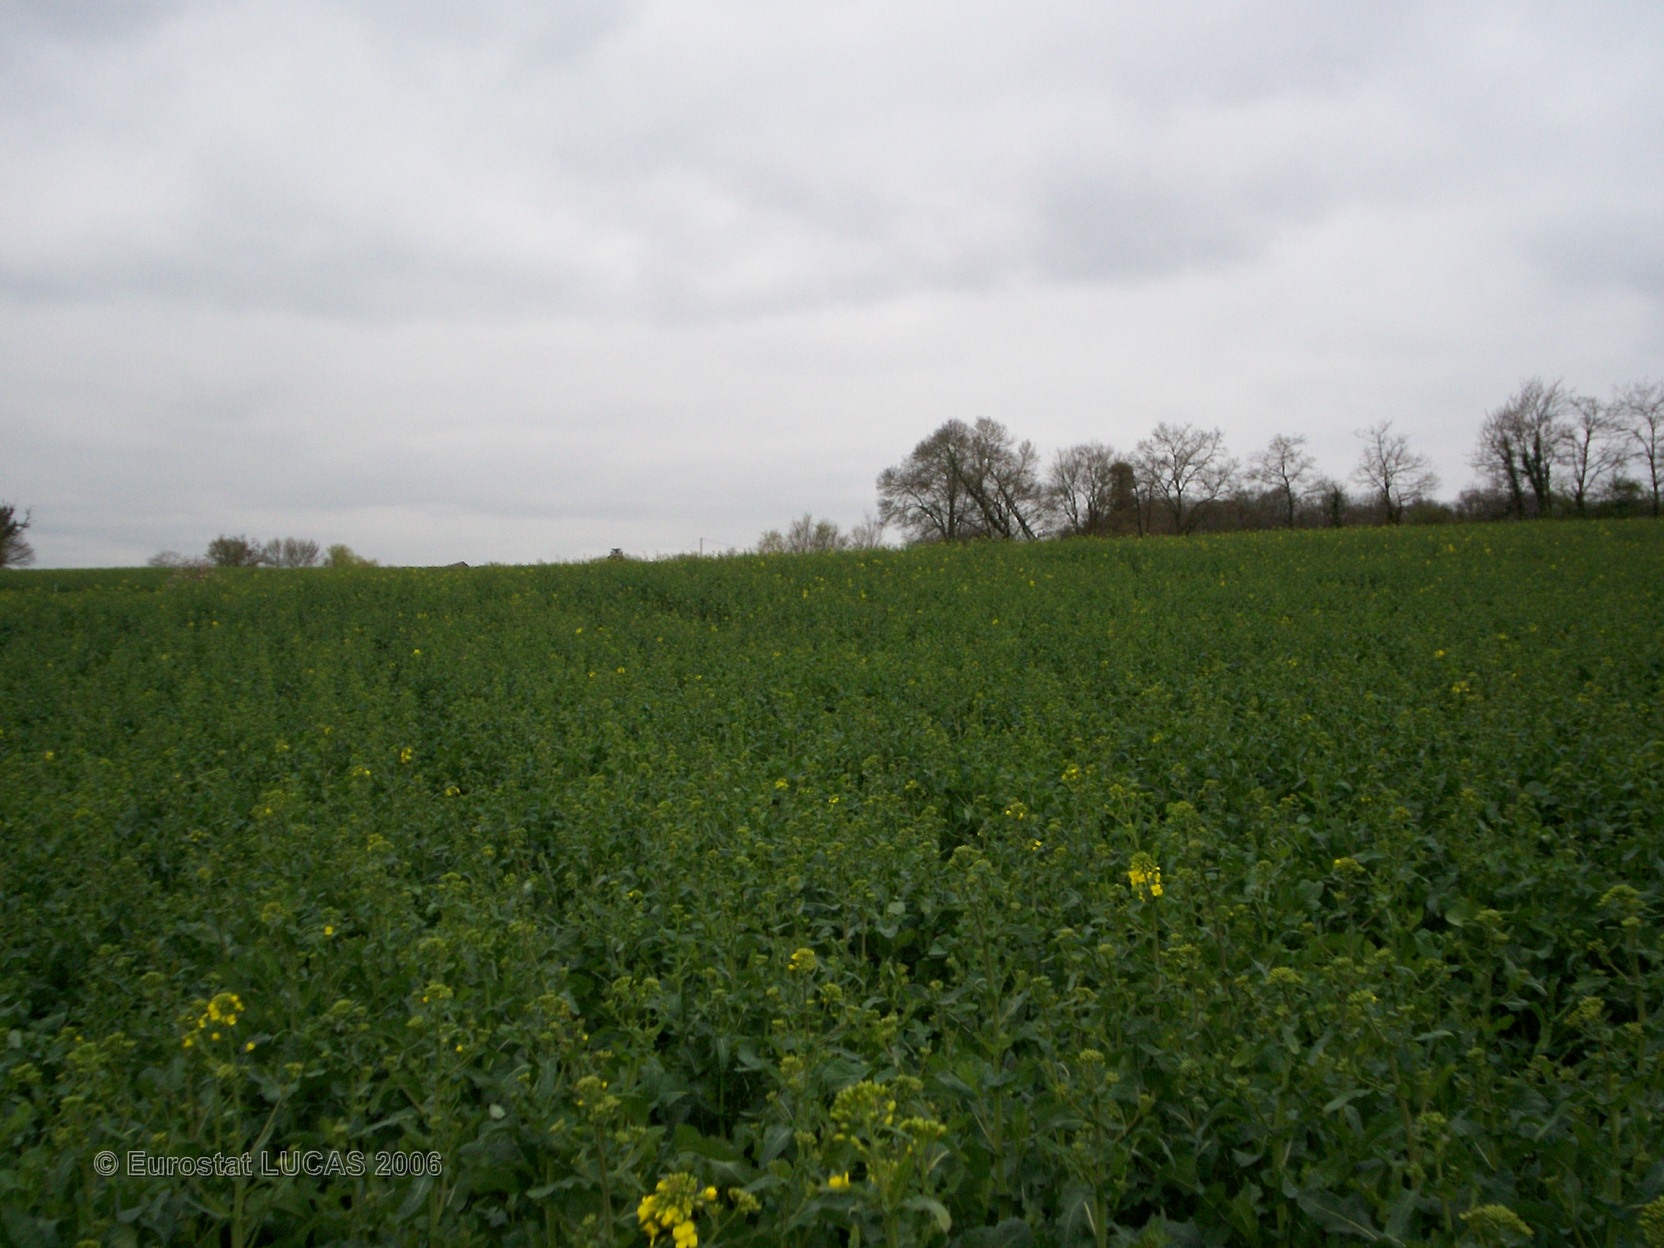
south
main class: Cropland
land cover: Rape and turnip rape
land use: Agriculture (excluding fallow land and kitchen gardens)
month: April
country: FR
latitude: 47.3355
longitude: -1.0873
